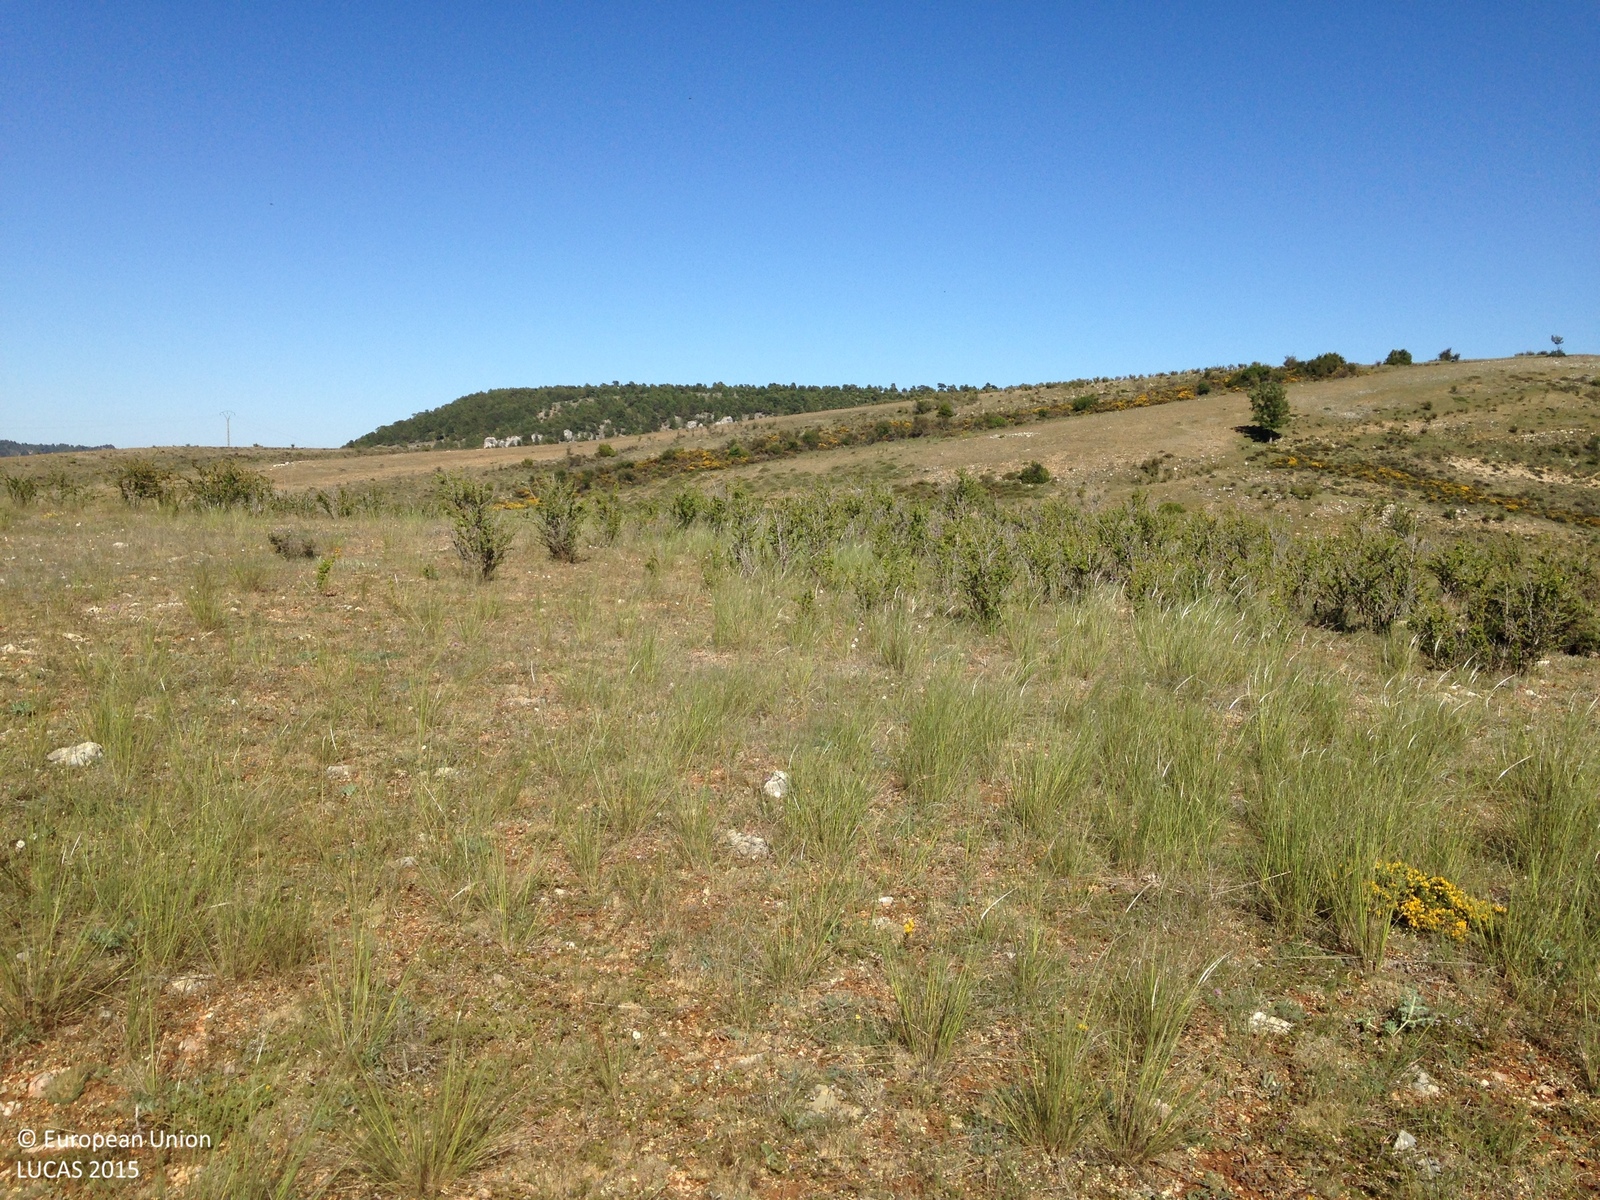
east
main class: Shrubland
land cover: Shrubland without tree cover
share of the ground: 25 - 50 %
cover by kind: herbaceous plants 60 %, shrubs 30 %, consolidated bare surface 10 %
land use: Semi-natural and natural areas not in use
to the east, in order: Shrubland without tree cover; Grassland without tree/shrub cover; Artificial constructions; Rivers and streams; Grassland without tree/shrub cover; Shrubland without tree cover
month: May
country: ES
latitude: 40.6515
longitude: -2.0730
